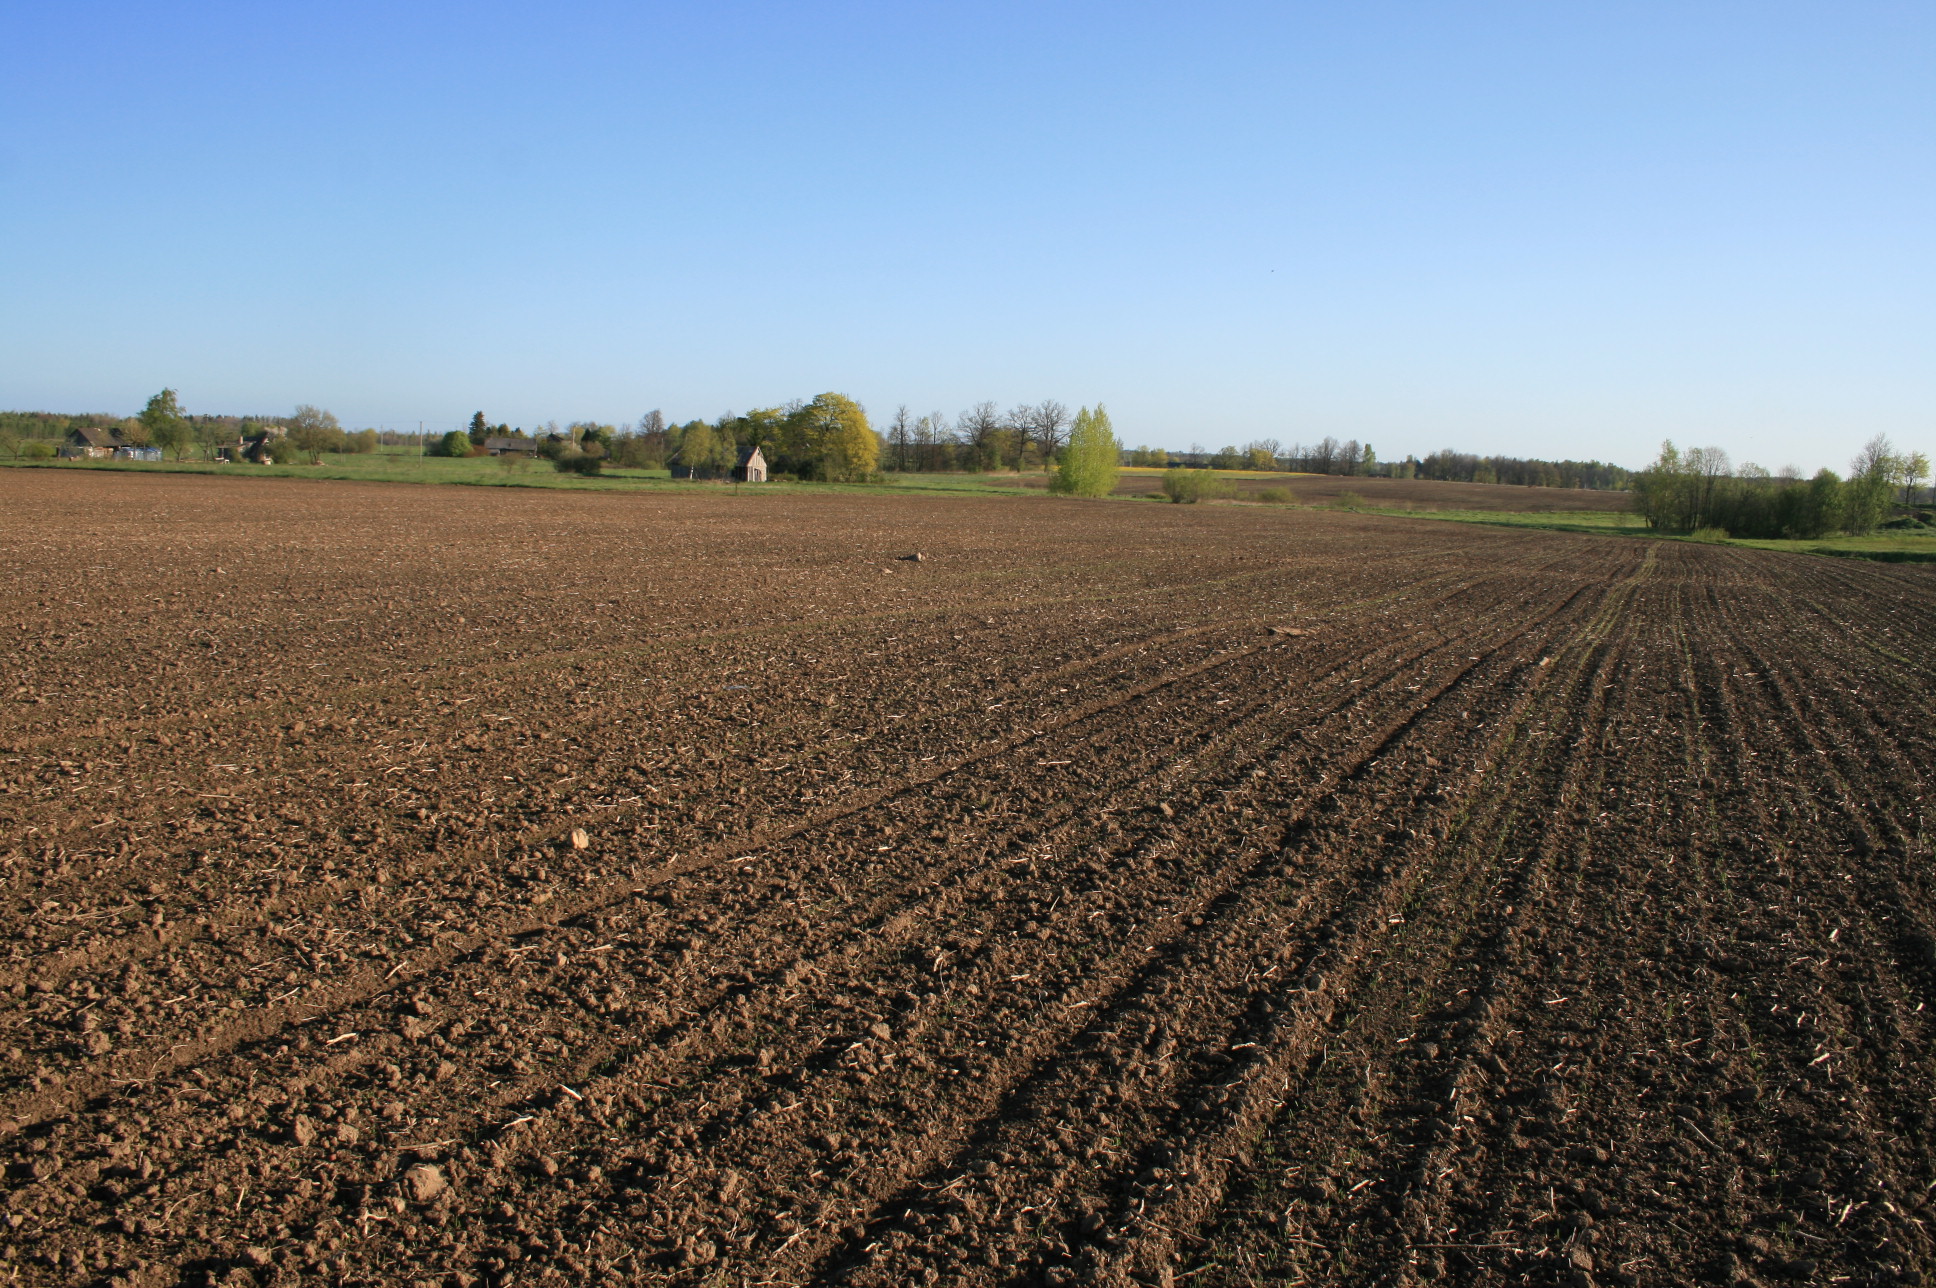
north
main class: Cropland
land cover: Common wheat
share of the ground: 10 - 25 %
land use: Agriculture (excluding fallow land and kitchen gardens)
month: May
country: LT
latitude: 56.2696
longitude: 21.4915
